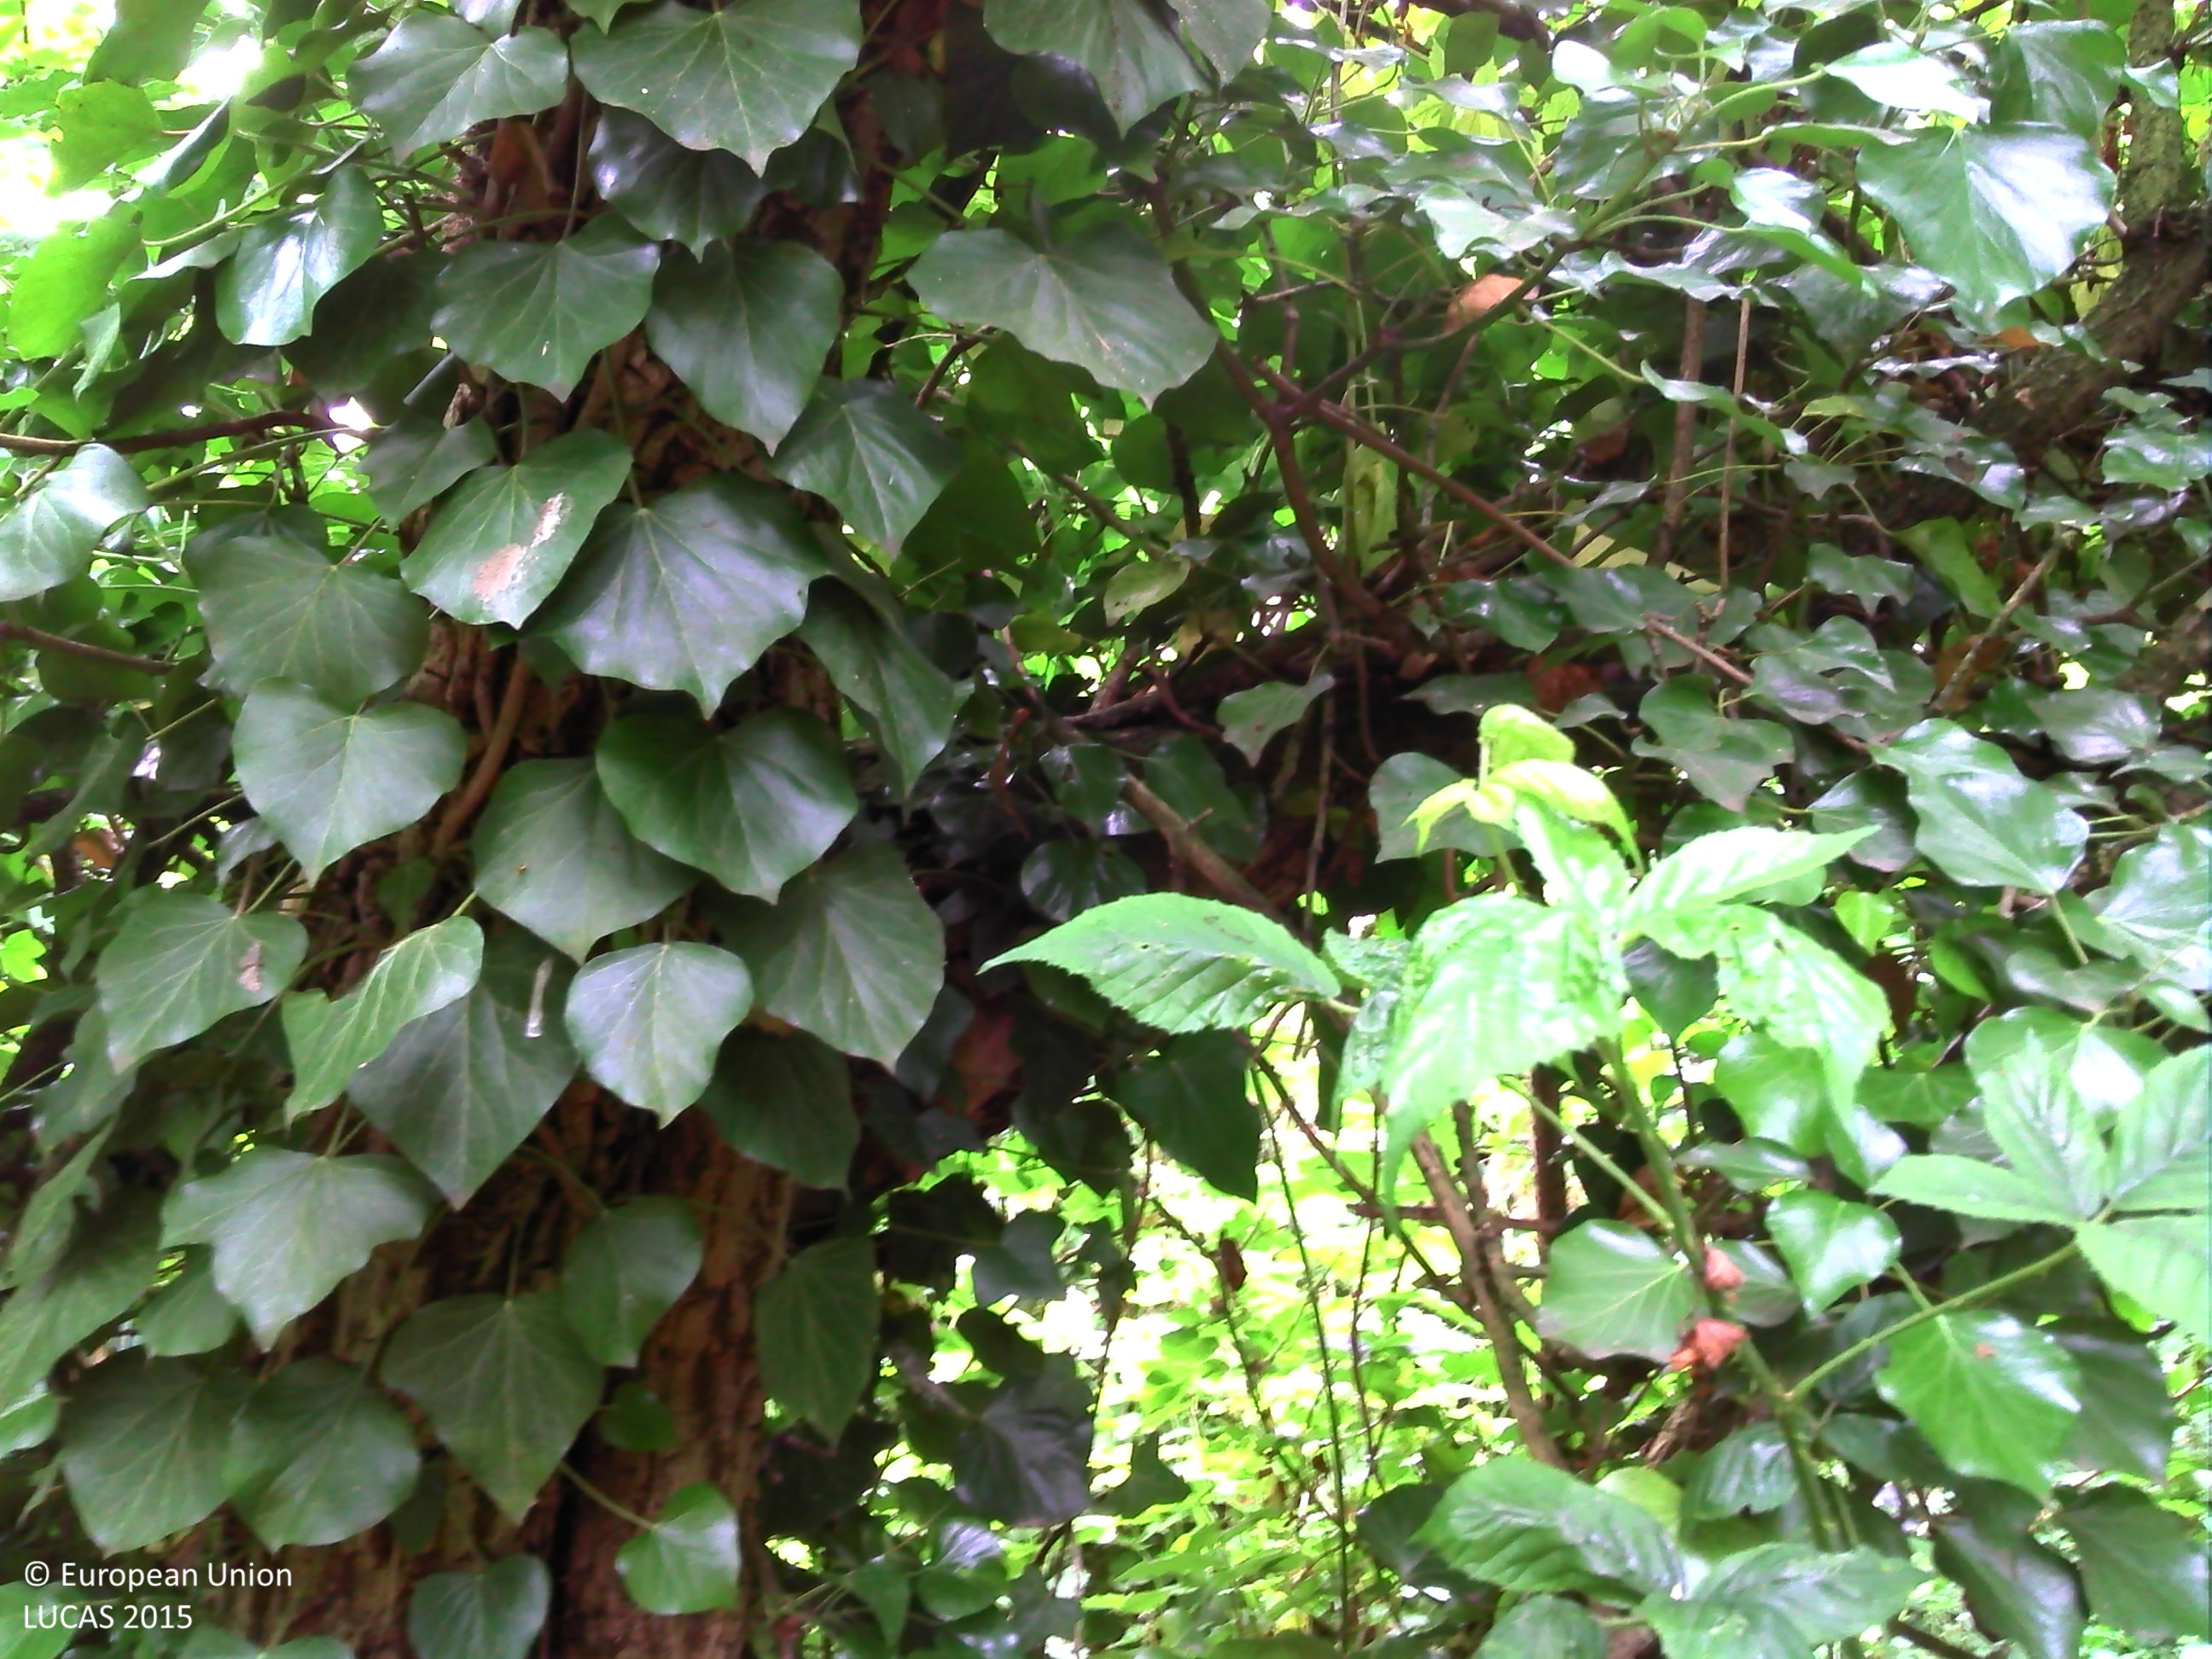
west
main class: Woodland
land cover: Broadleaved woodland
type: non-riverine alder, birch or aspen forest
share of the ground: > 75 %
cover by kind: broadleaved forest trees 60 %, herbaceous plants 40 %
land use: Semi-natural and natural areas not in use
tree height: > 5 m
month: June
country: BE
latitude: 50.6195
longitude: 5.5460
